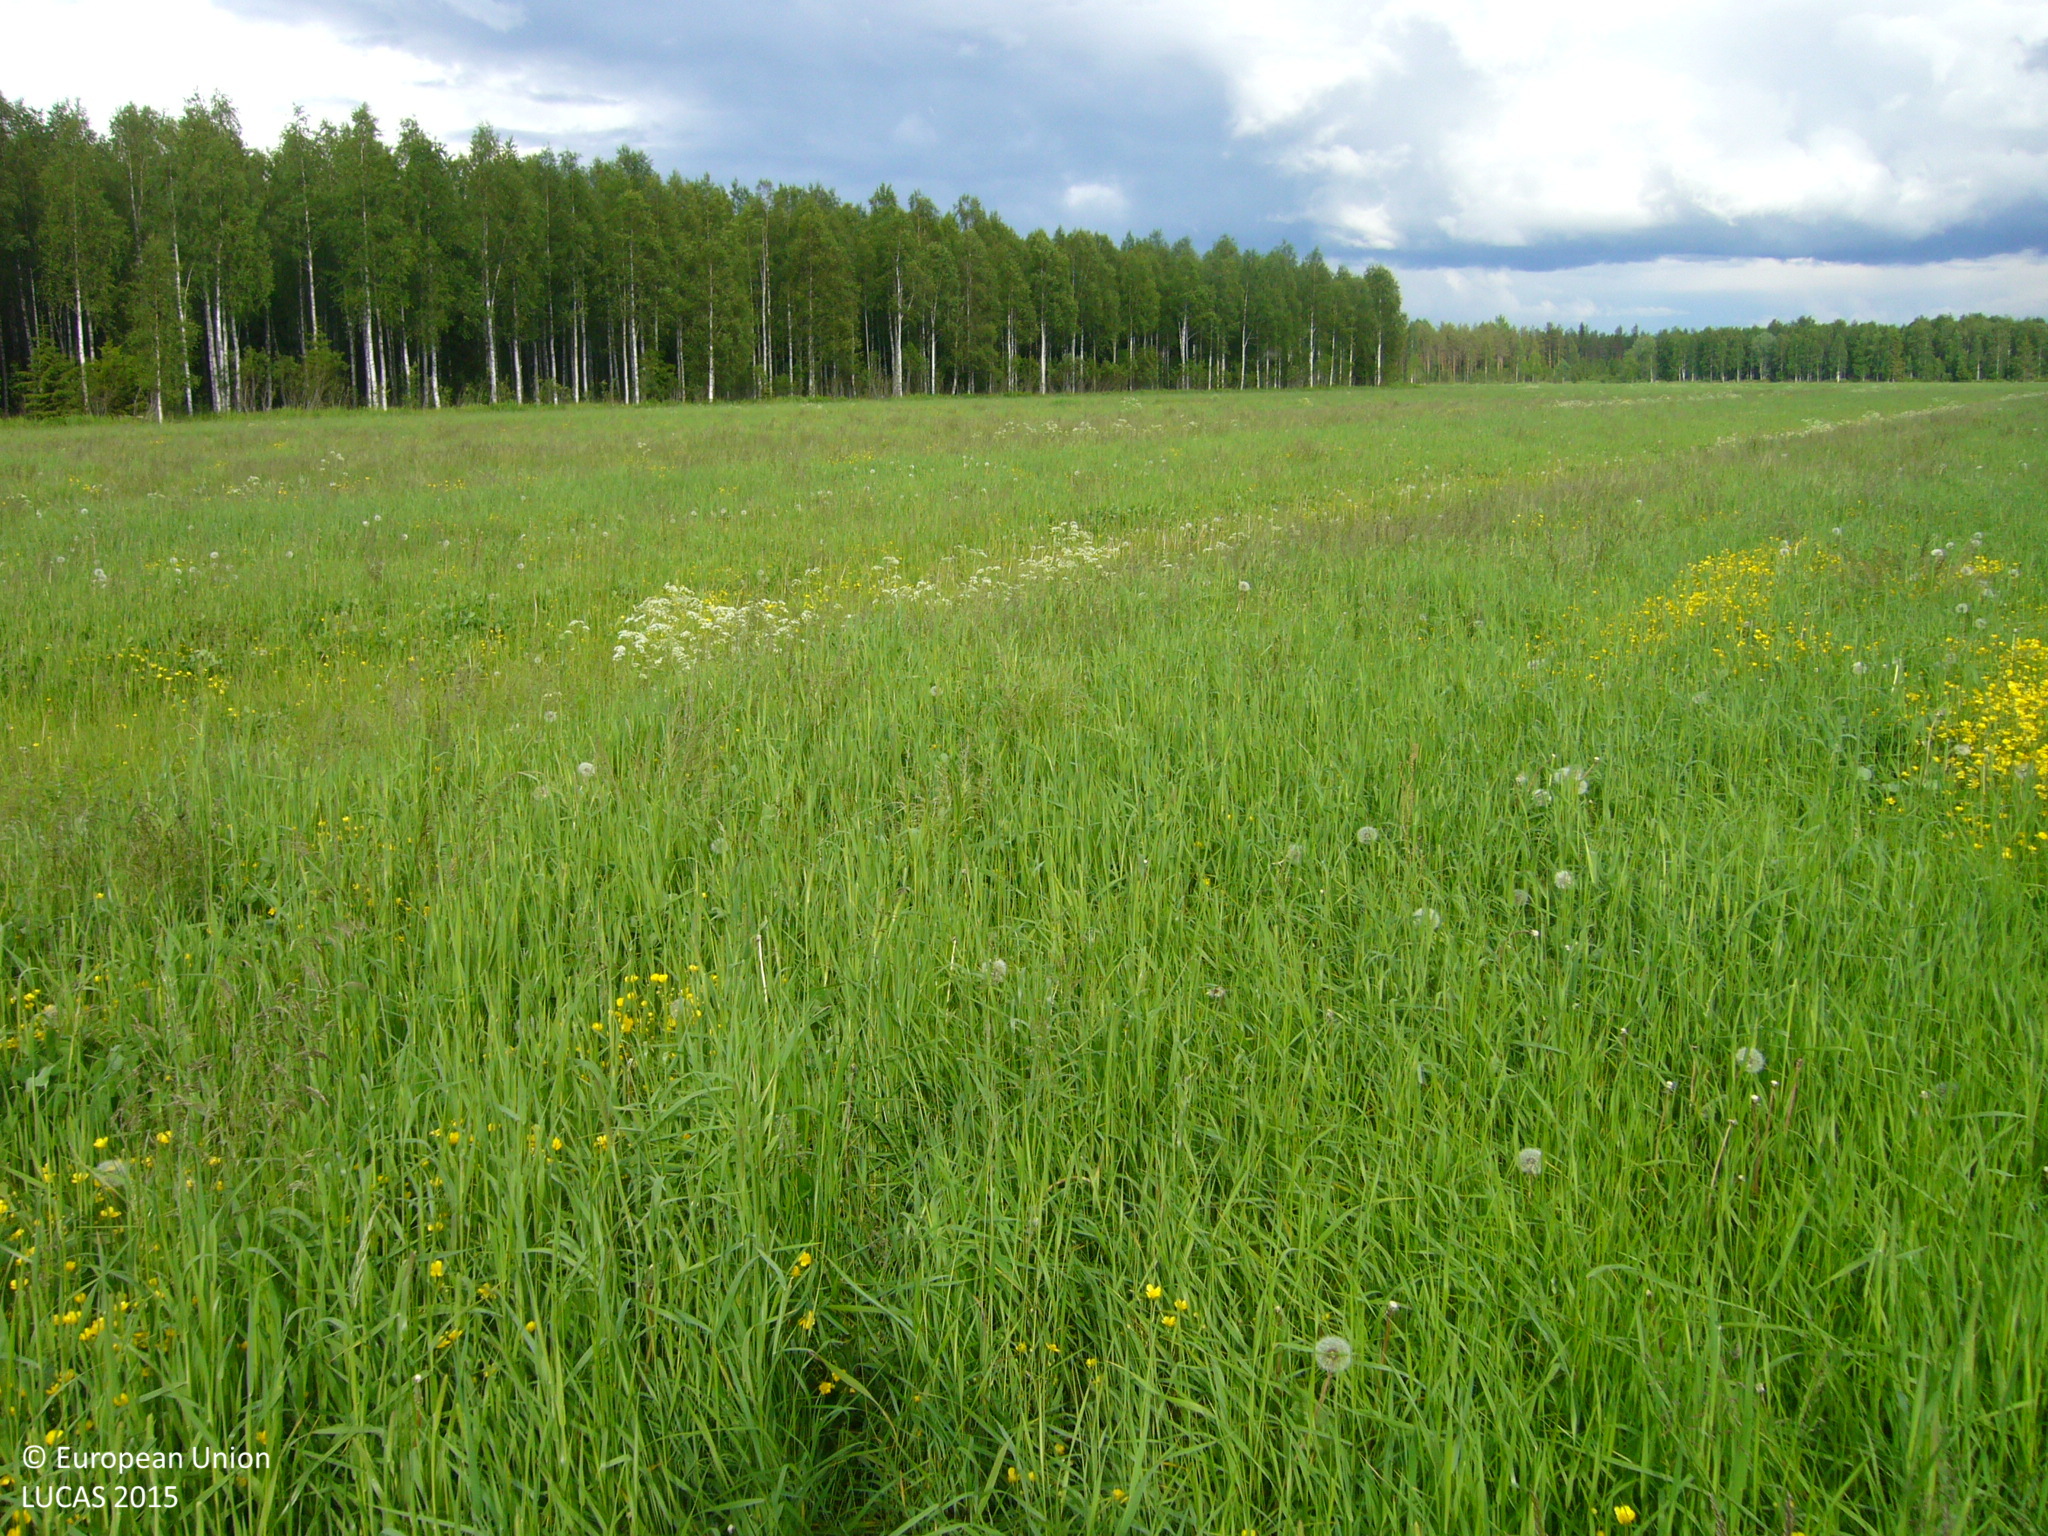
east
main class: Cropland
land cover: Temporary grasslands
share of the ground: > 75 %
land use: Agriculture (excluding fallow land and kitchen gardens)
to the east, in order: Temporary grasslands; Ditches and canals; Temporary grasslands; Ditches and canals; Temporary grasslands; Ditches and canals; Temporary grasslands; Ditches and canals; Temporary grasslands; Ditches and canals; Temporary grasslands; Ditches and canals; Broadleaved woodland; Ditches and canals; Broadleaved woodland; Ditches and canals; Broadleaved woodland
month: June
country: FI
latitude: 63.7318
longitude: 26.3000
